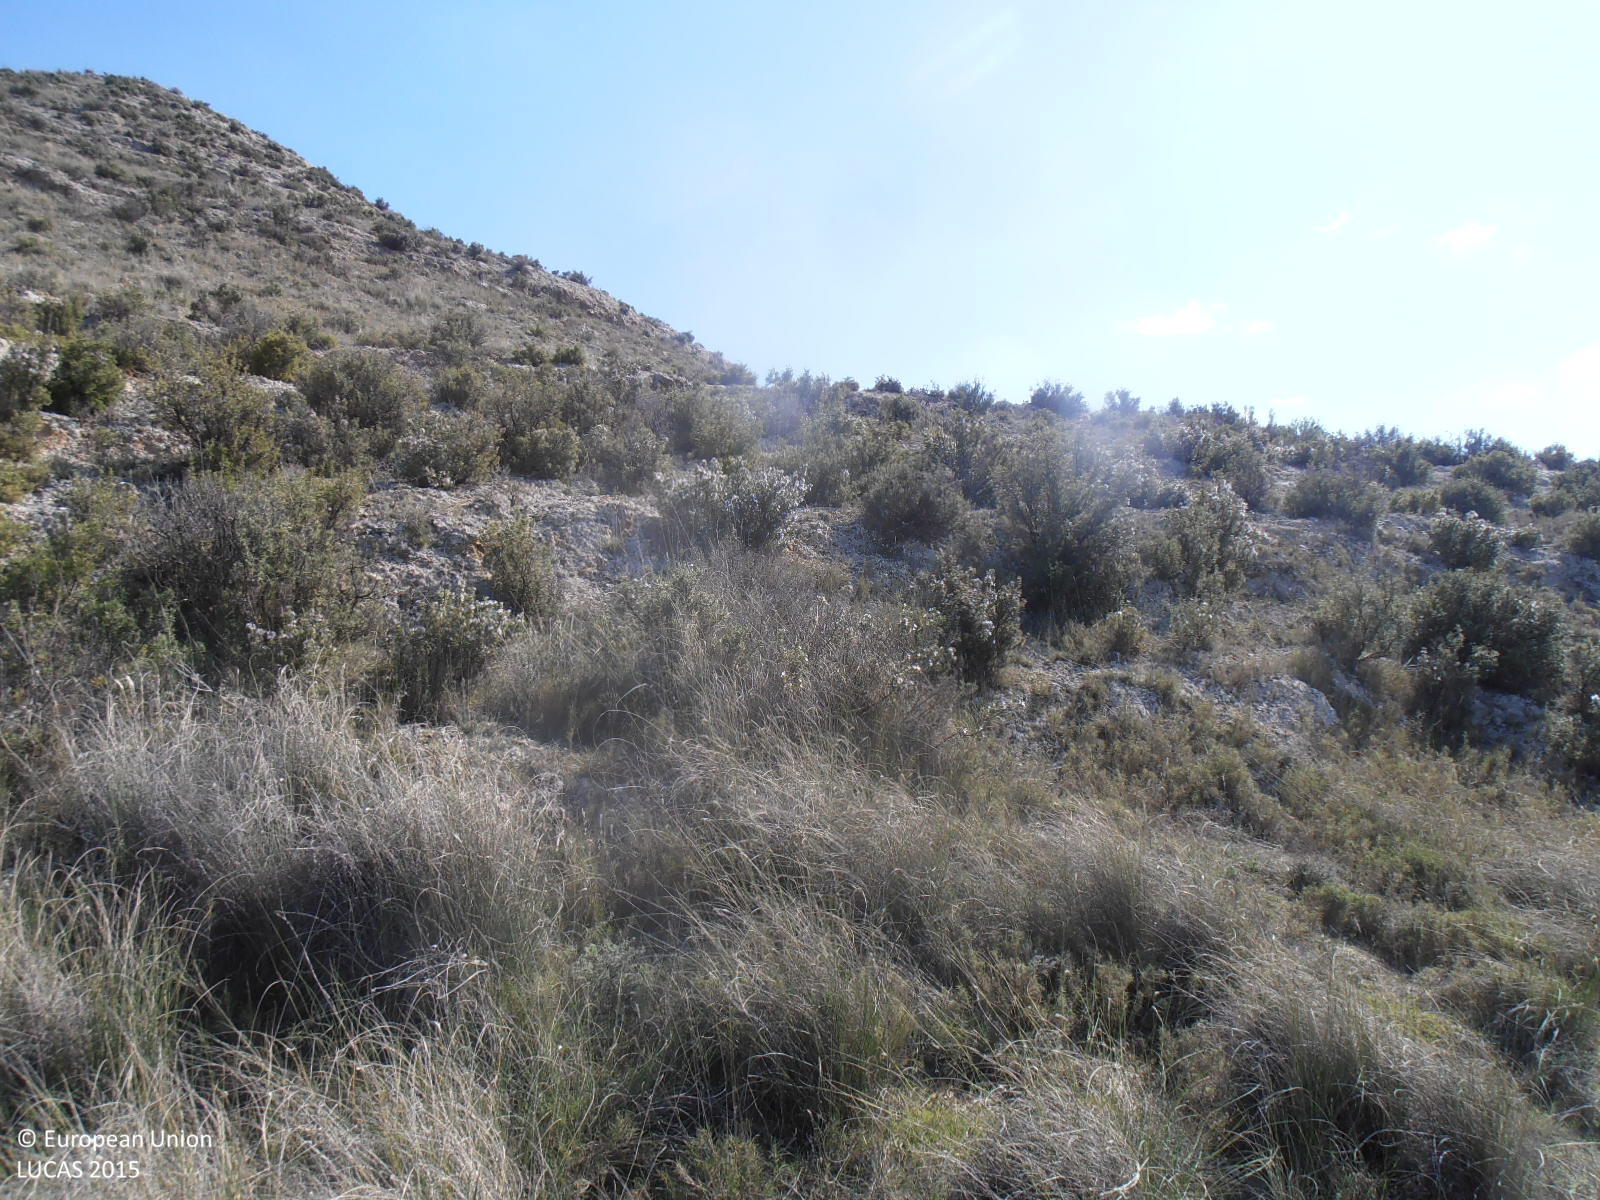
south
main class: Shrubland
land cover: Shrubland without tree cover
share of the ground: 50 - 75 %
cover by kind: shrubs 55 %, consolidated bare surface 45 %
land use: Semi-natural and natural areas not in use
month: April
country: ES
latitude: 41.5467
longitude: -0.9666
